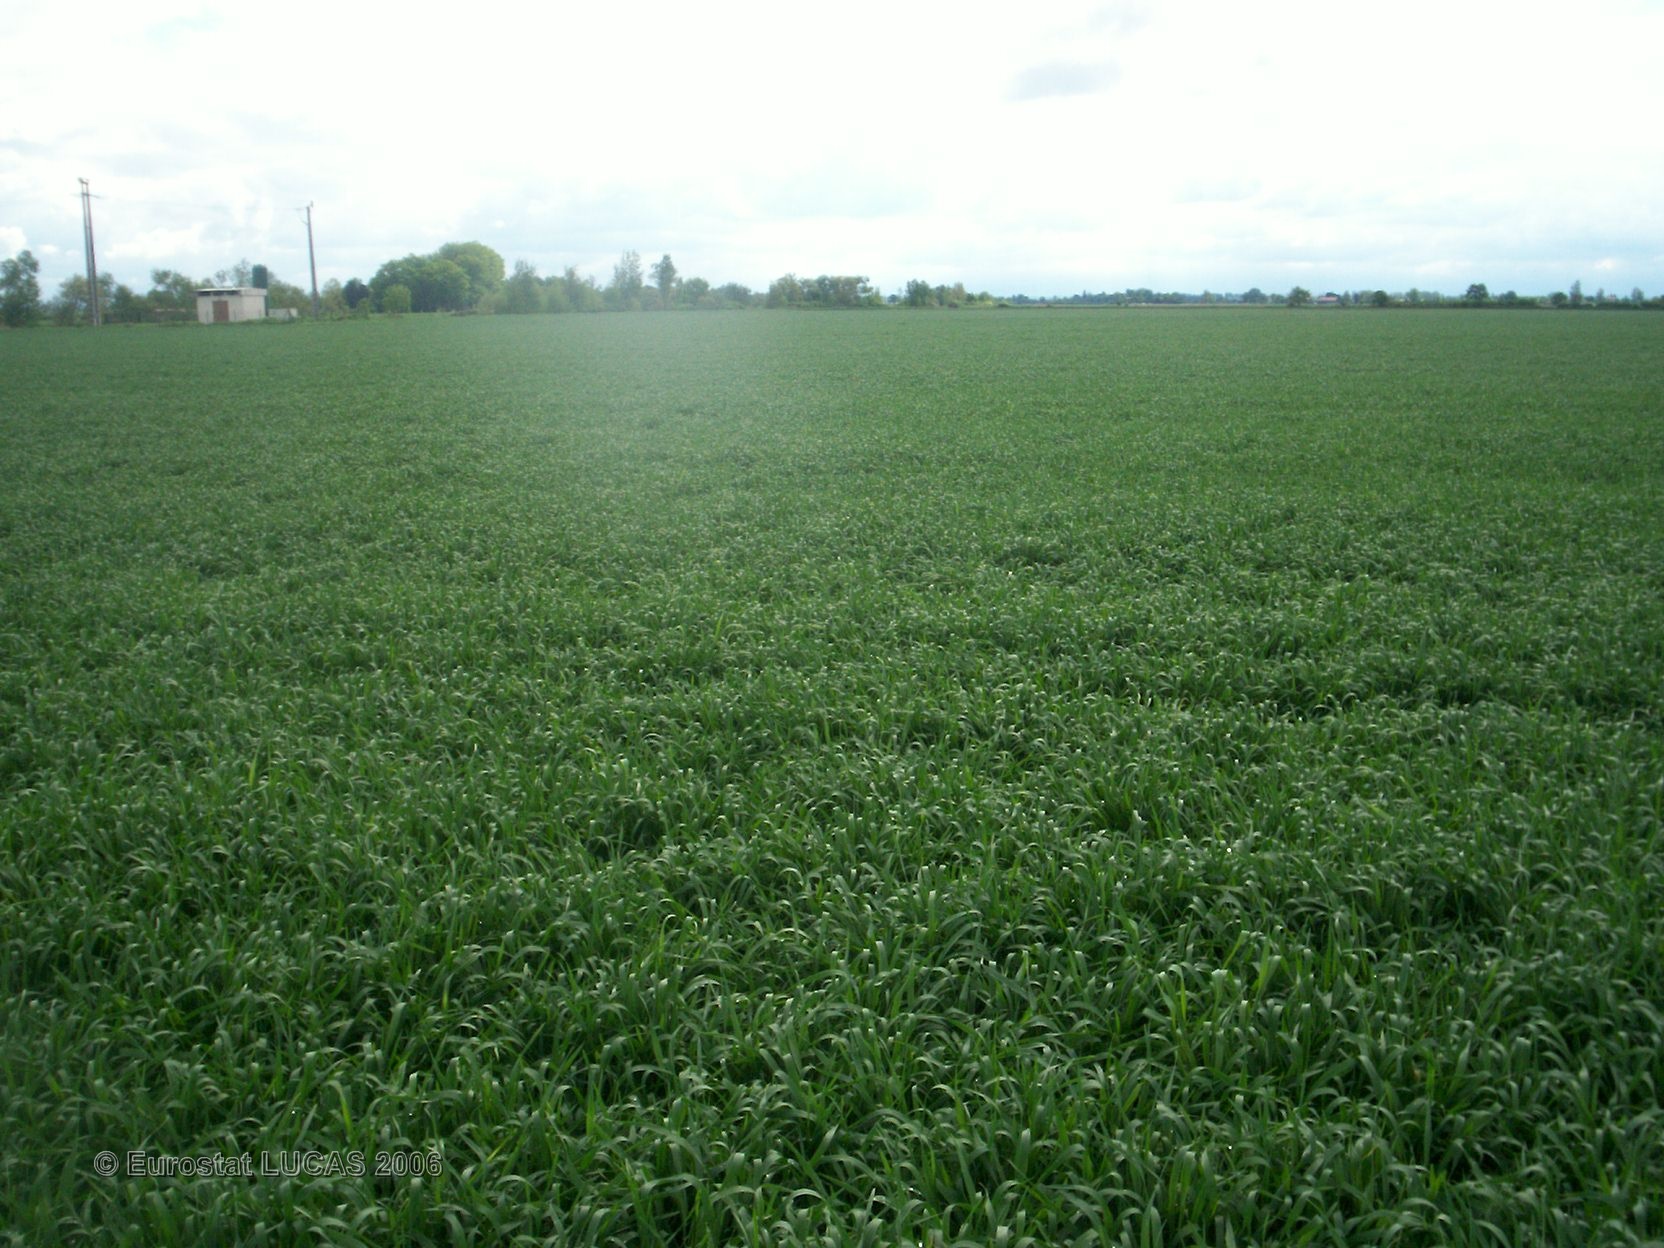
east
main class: Cropland
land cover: Barley
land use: Agriculture (excluding fallow land and kitchen gardens)
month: May
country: FR
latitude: 45.8969
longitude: 3.1557
